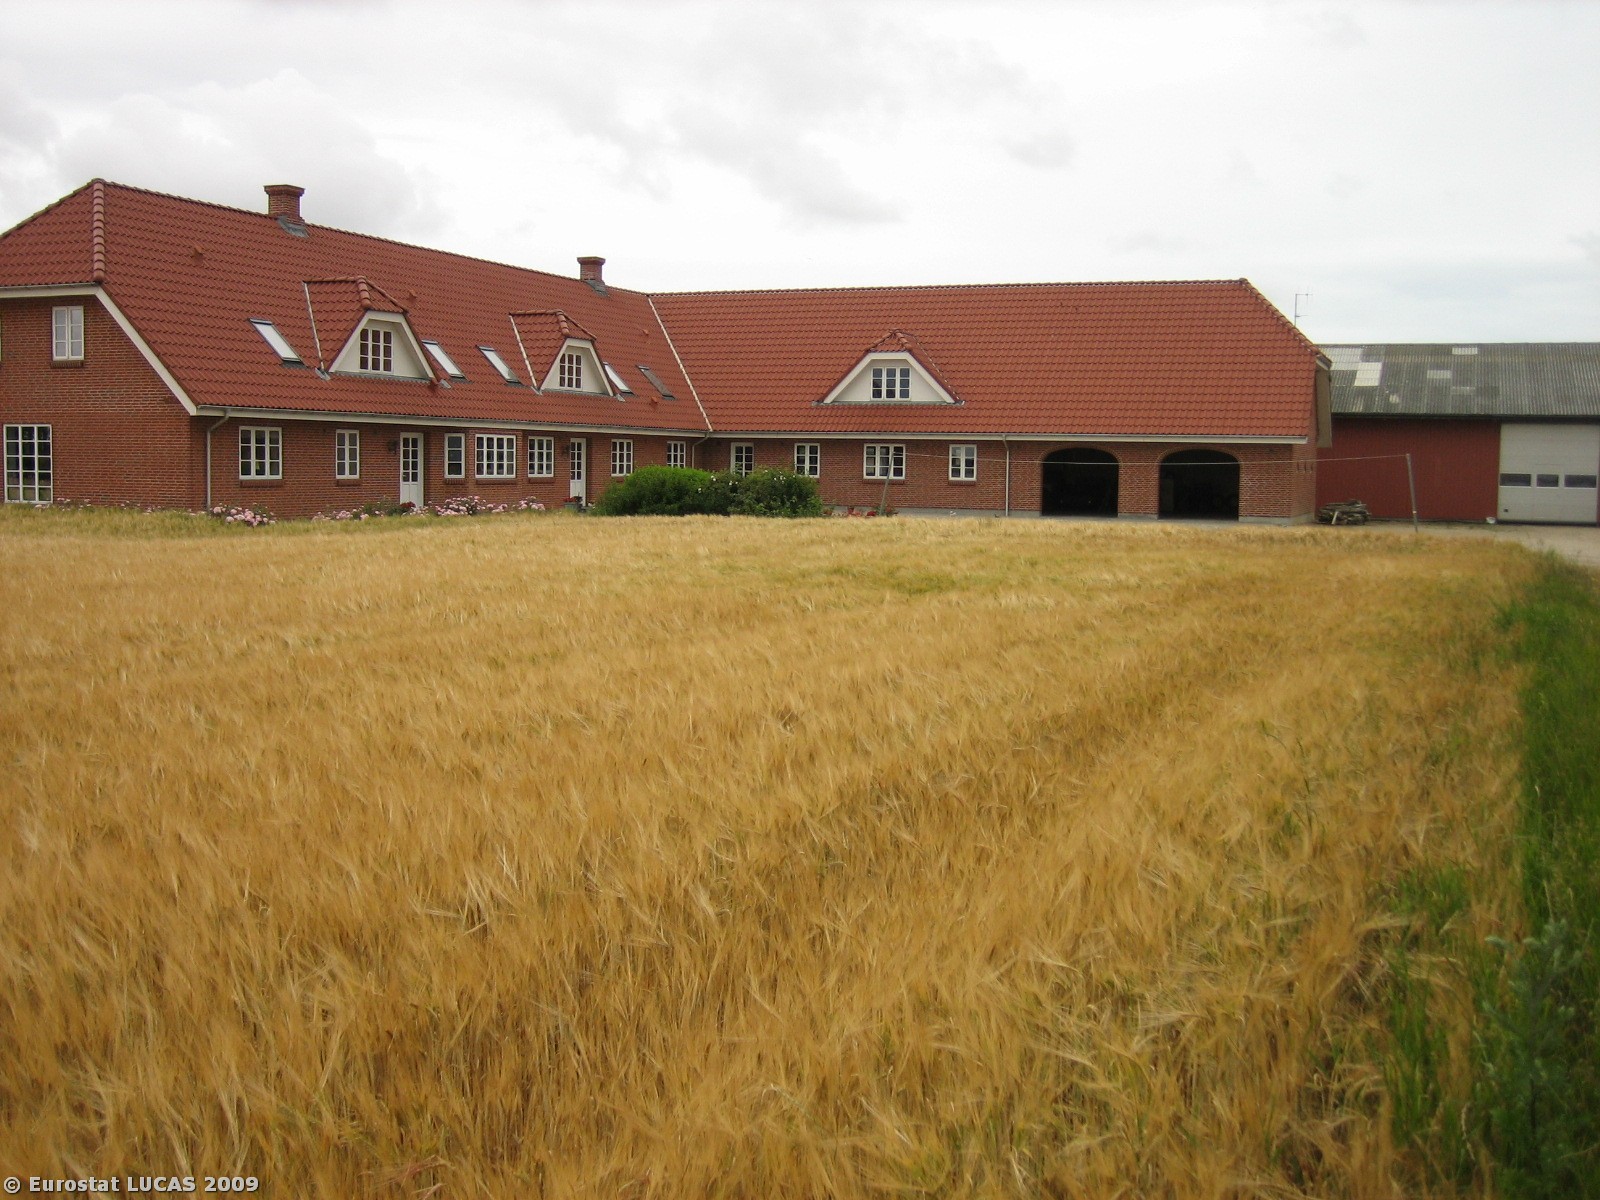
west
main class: Cropland
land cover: Barley
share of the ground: > 75 %
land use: Agriculture (excluding fallow land and kitchen gardens)
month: July
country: DK
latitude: 55.6012
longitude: 8.3033
